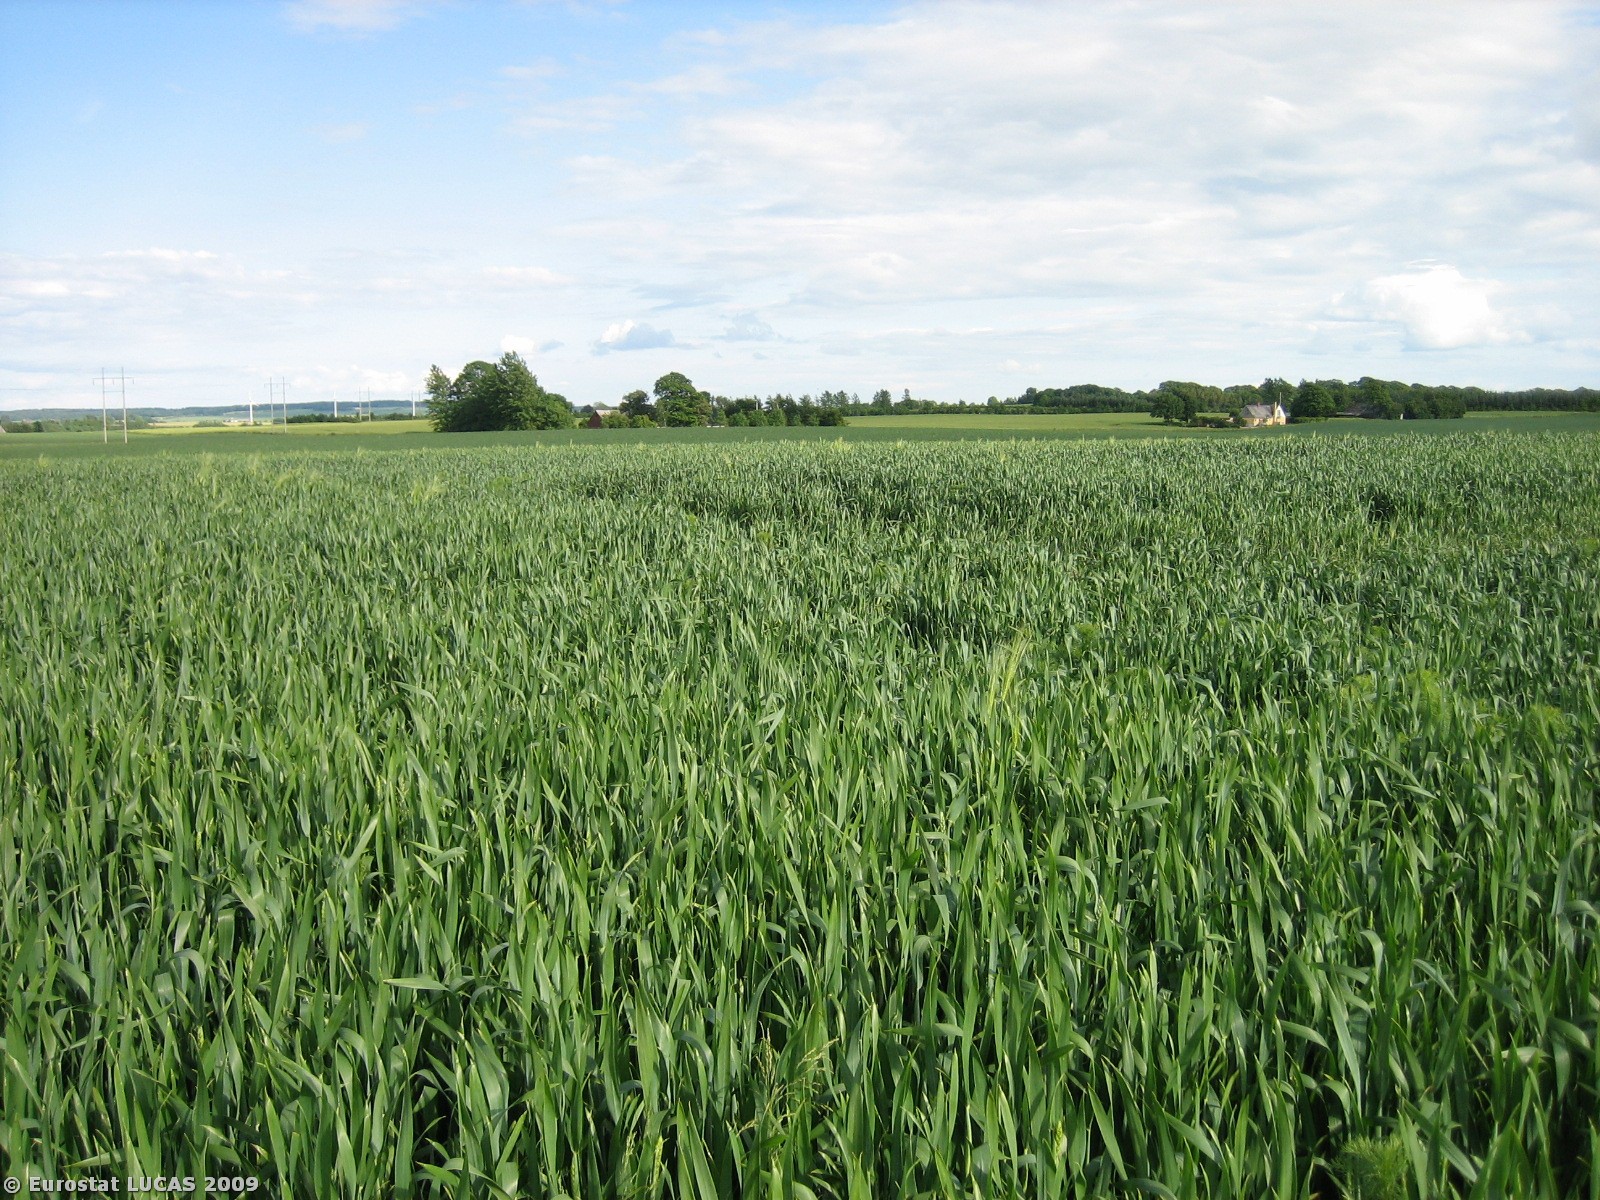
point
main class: Cropland
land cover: Common wheat
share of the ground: > 75 %
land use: Agriculture (excluding fallow land and kitchen gardens)
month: June
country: DK
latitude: 56.2235
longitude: 9.7906
